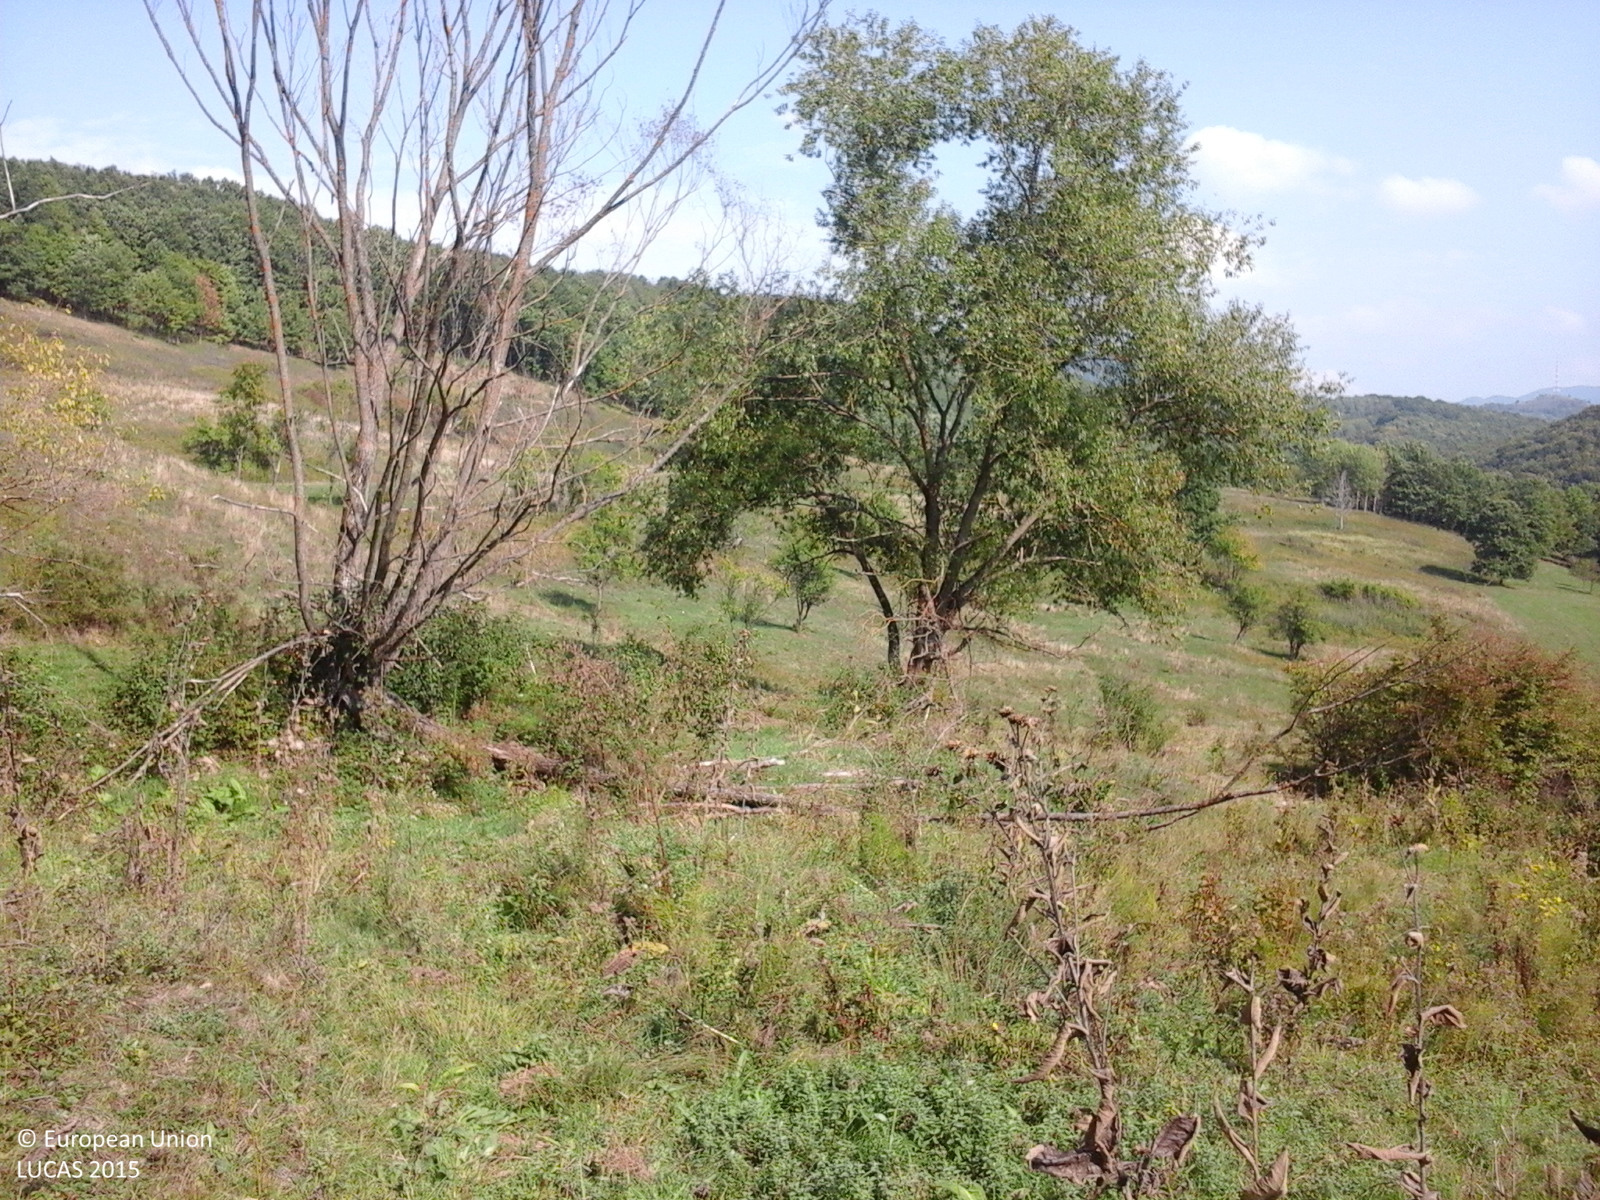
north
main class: Grassland
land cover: Spontaneously vegetated surfaces
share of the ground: > 75 %
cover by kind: herbaceous plants 100 %
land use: Fallow land
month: September
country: RO
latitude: 45.9680
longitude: 22.8947
